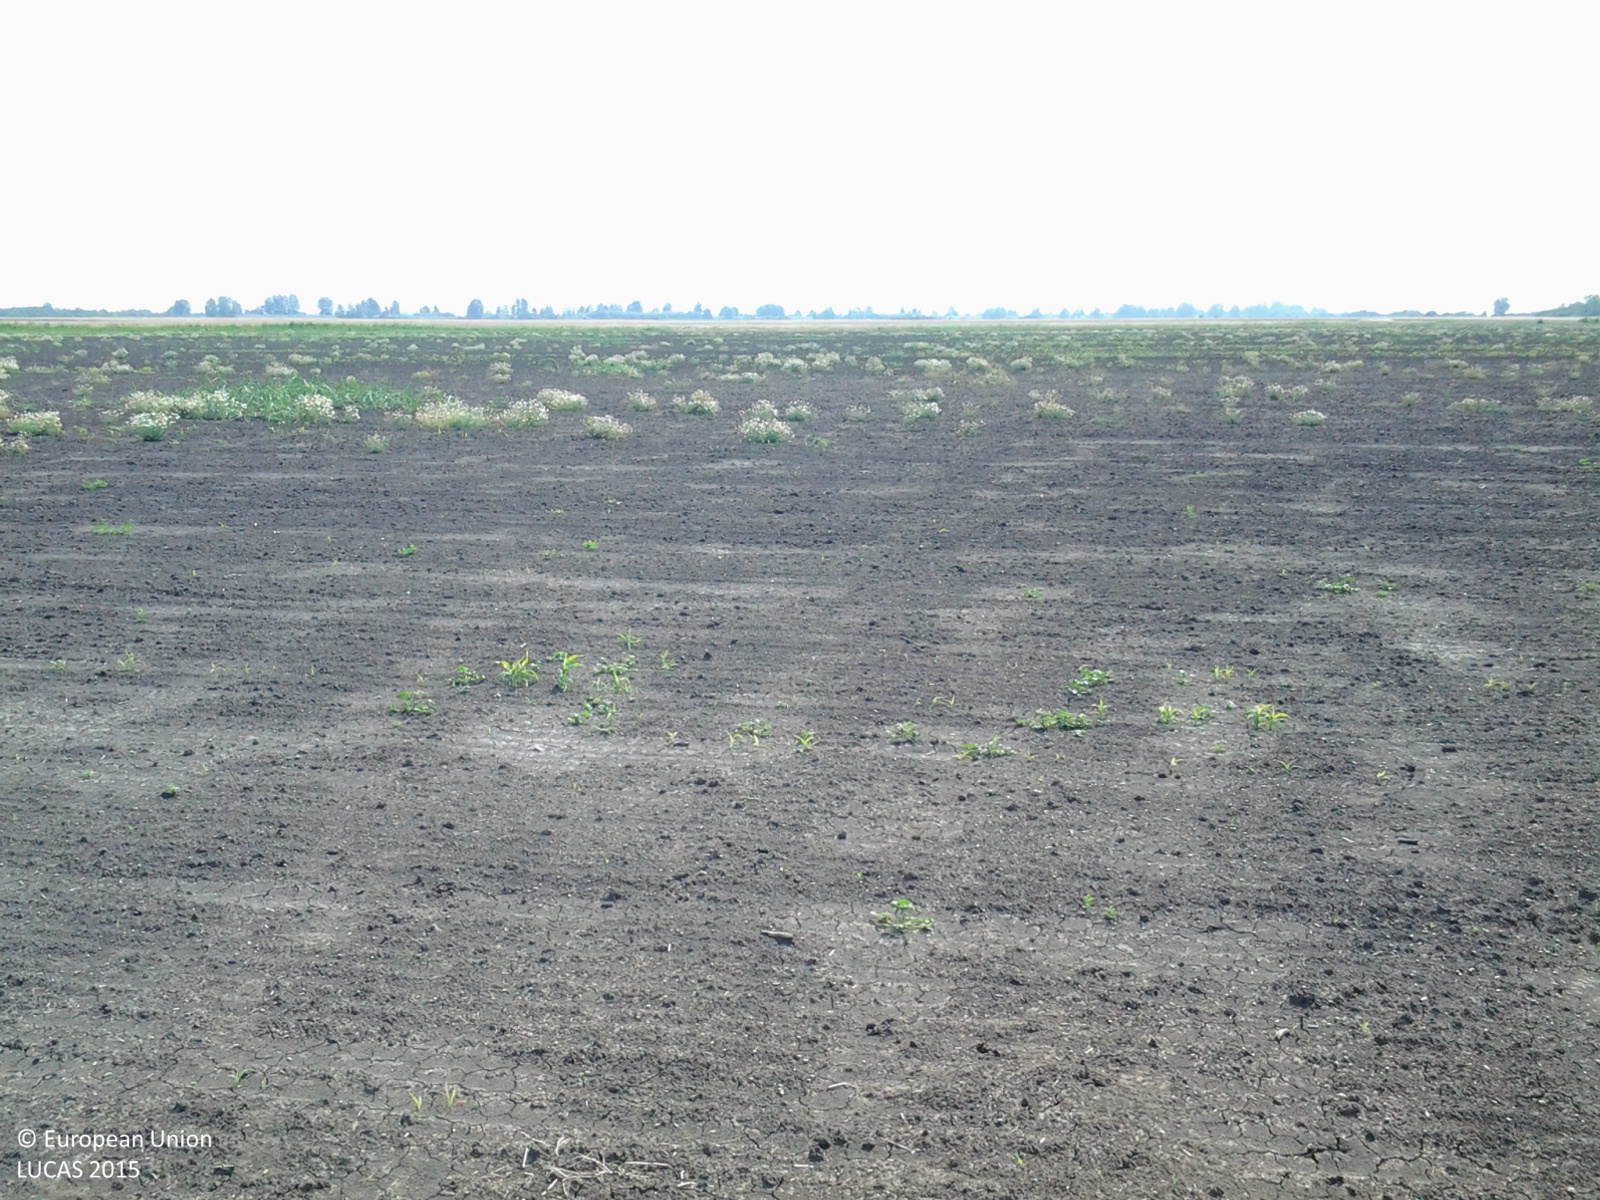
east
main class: Cropland
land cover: Maize
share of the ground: < 10 %
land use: Agriculture (excluding fallow land and kitchen gardens)
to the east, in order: Maize
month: July
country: HU
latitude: 46.9812
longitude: 20.4535
